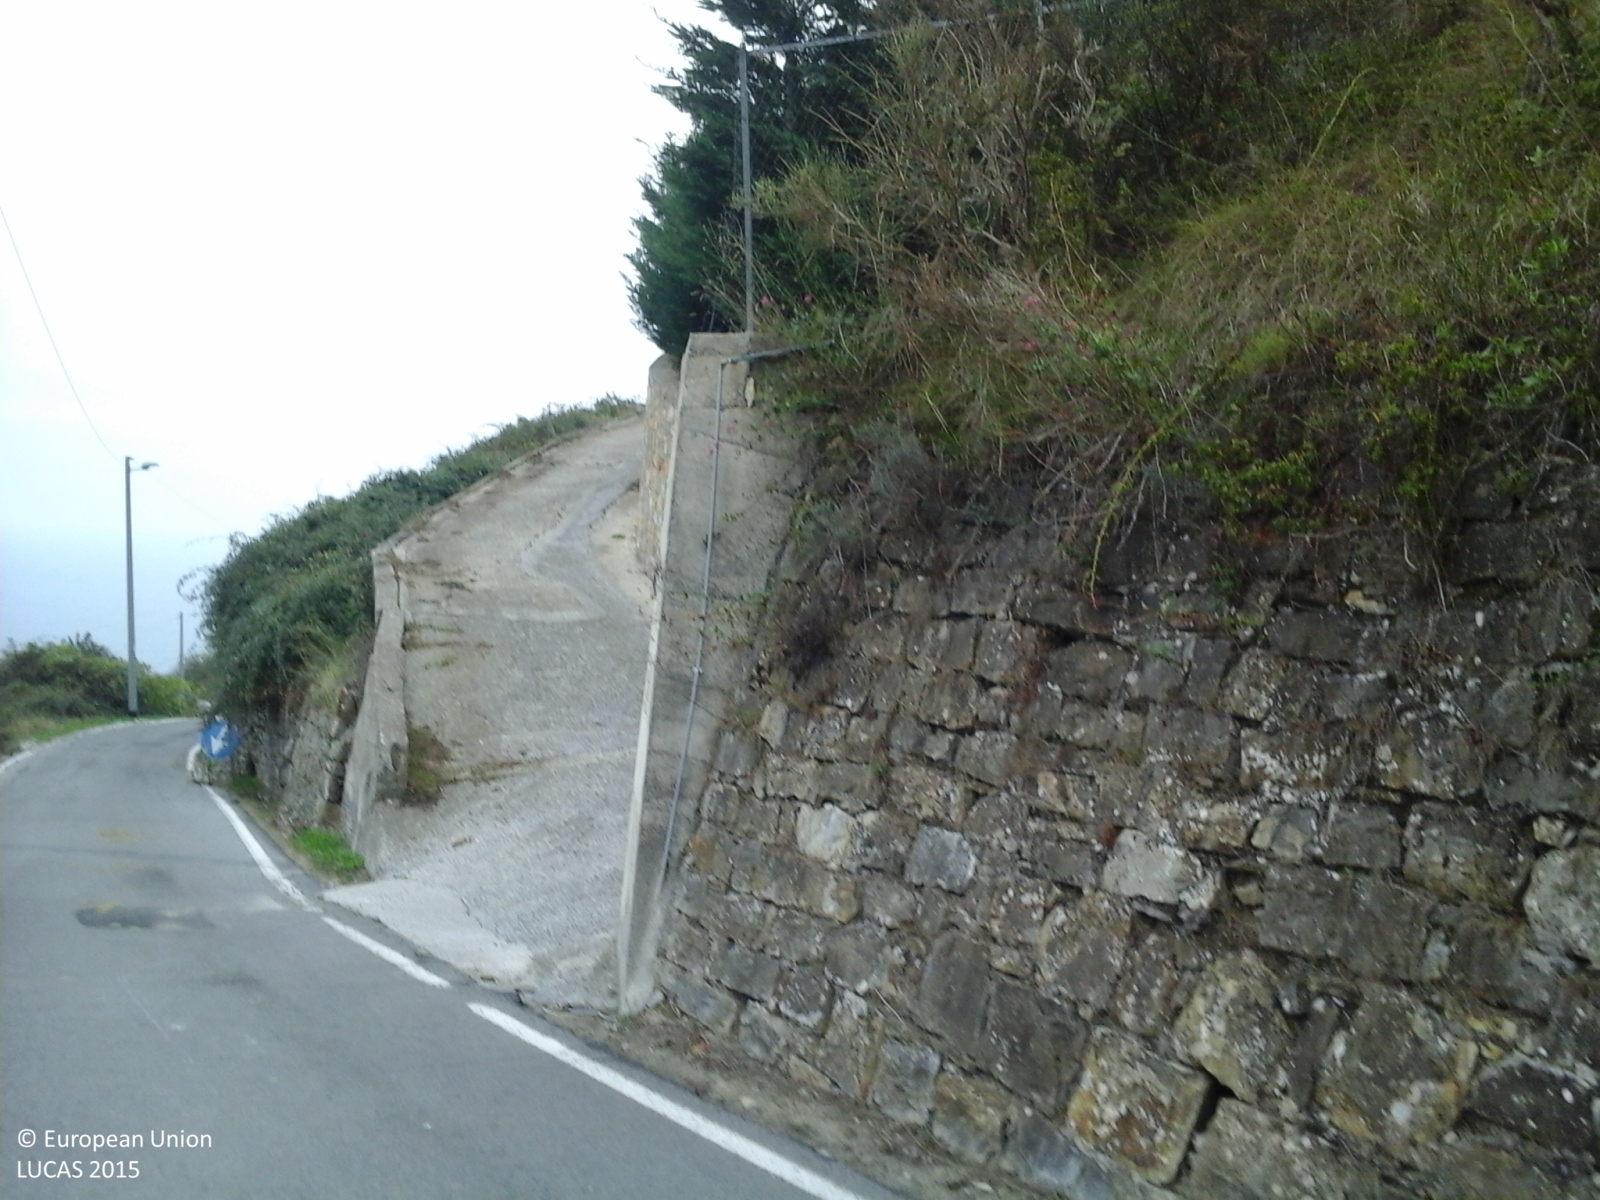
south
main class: Shrubland
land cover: Shrubland with sparse tree cover
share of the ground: > 75 %
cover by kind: shrubs 60 %, herbaceous plants 30 %, broadleaved forest trees 5 %, consolidated bare surface 5 %
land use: Semi-natural and natural areas not in use
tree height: > 5 m
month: October
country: IT
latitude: 43.8205
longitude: 7.7303
